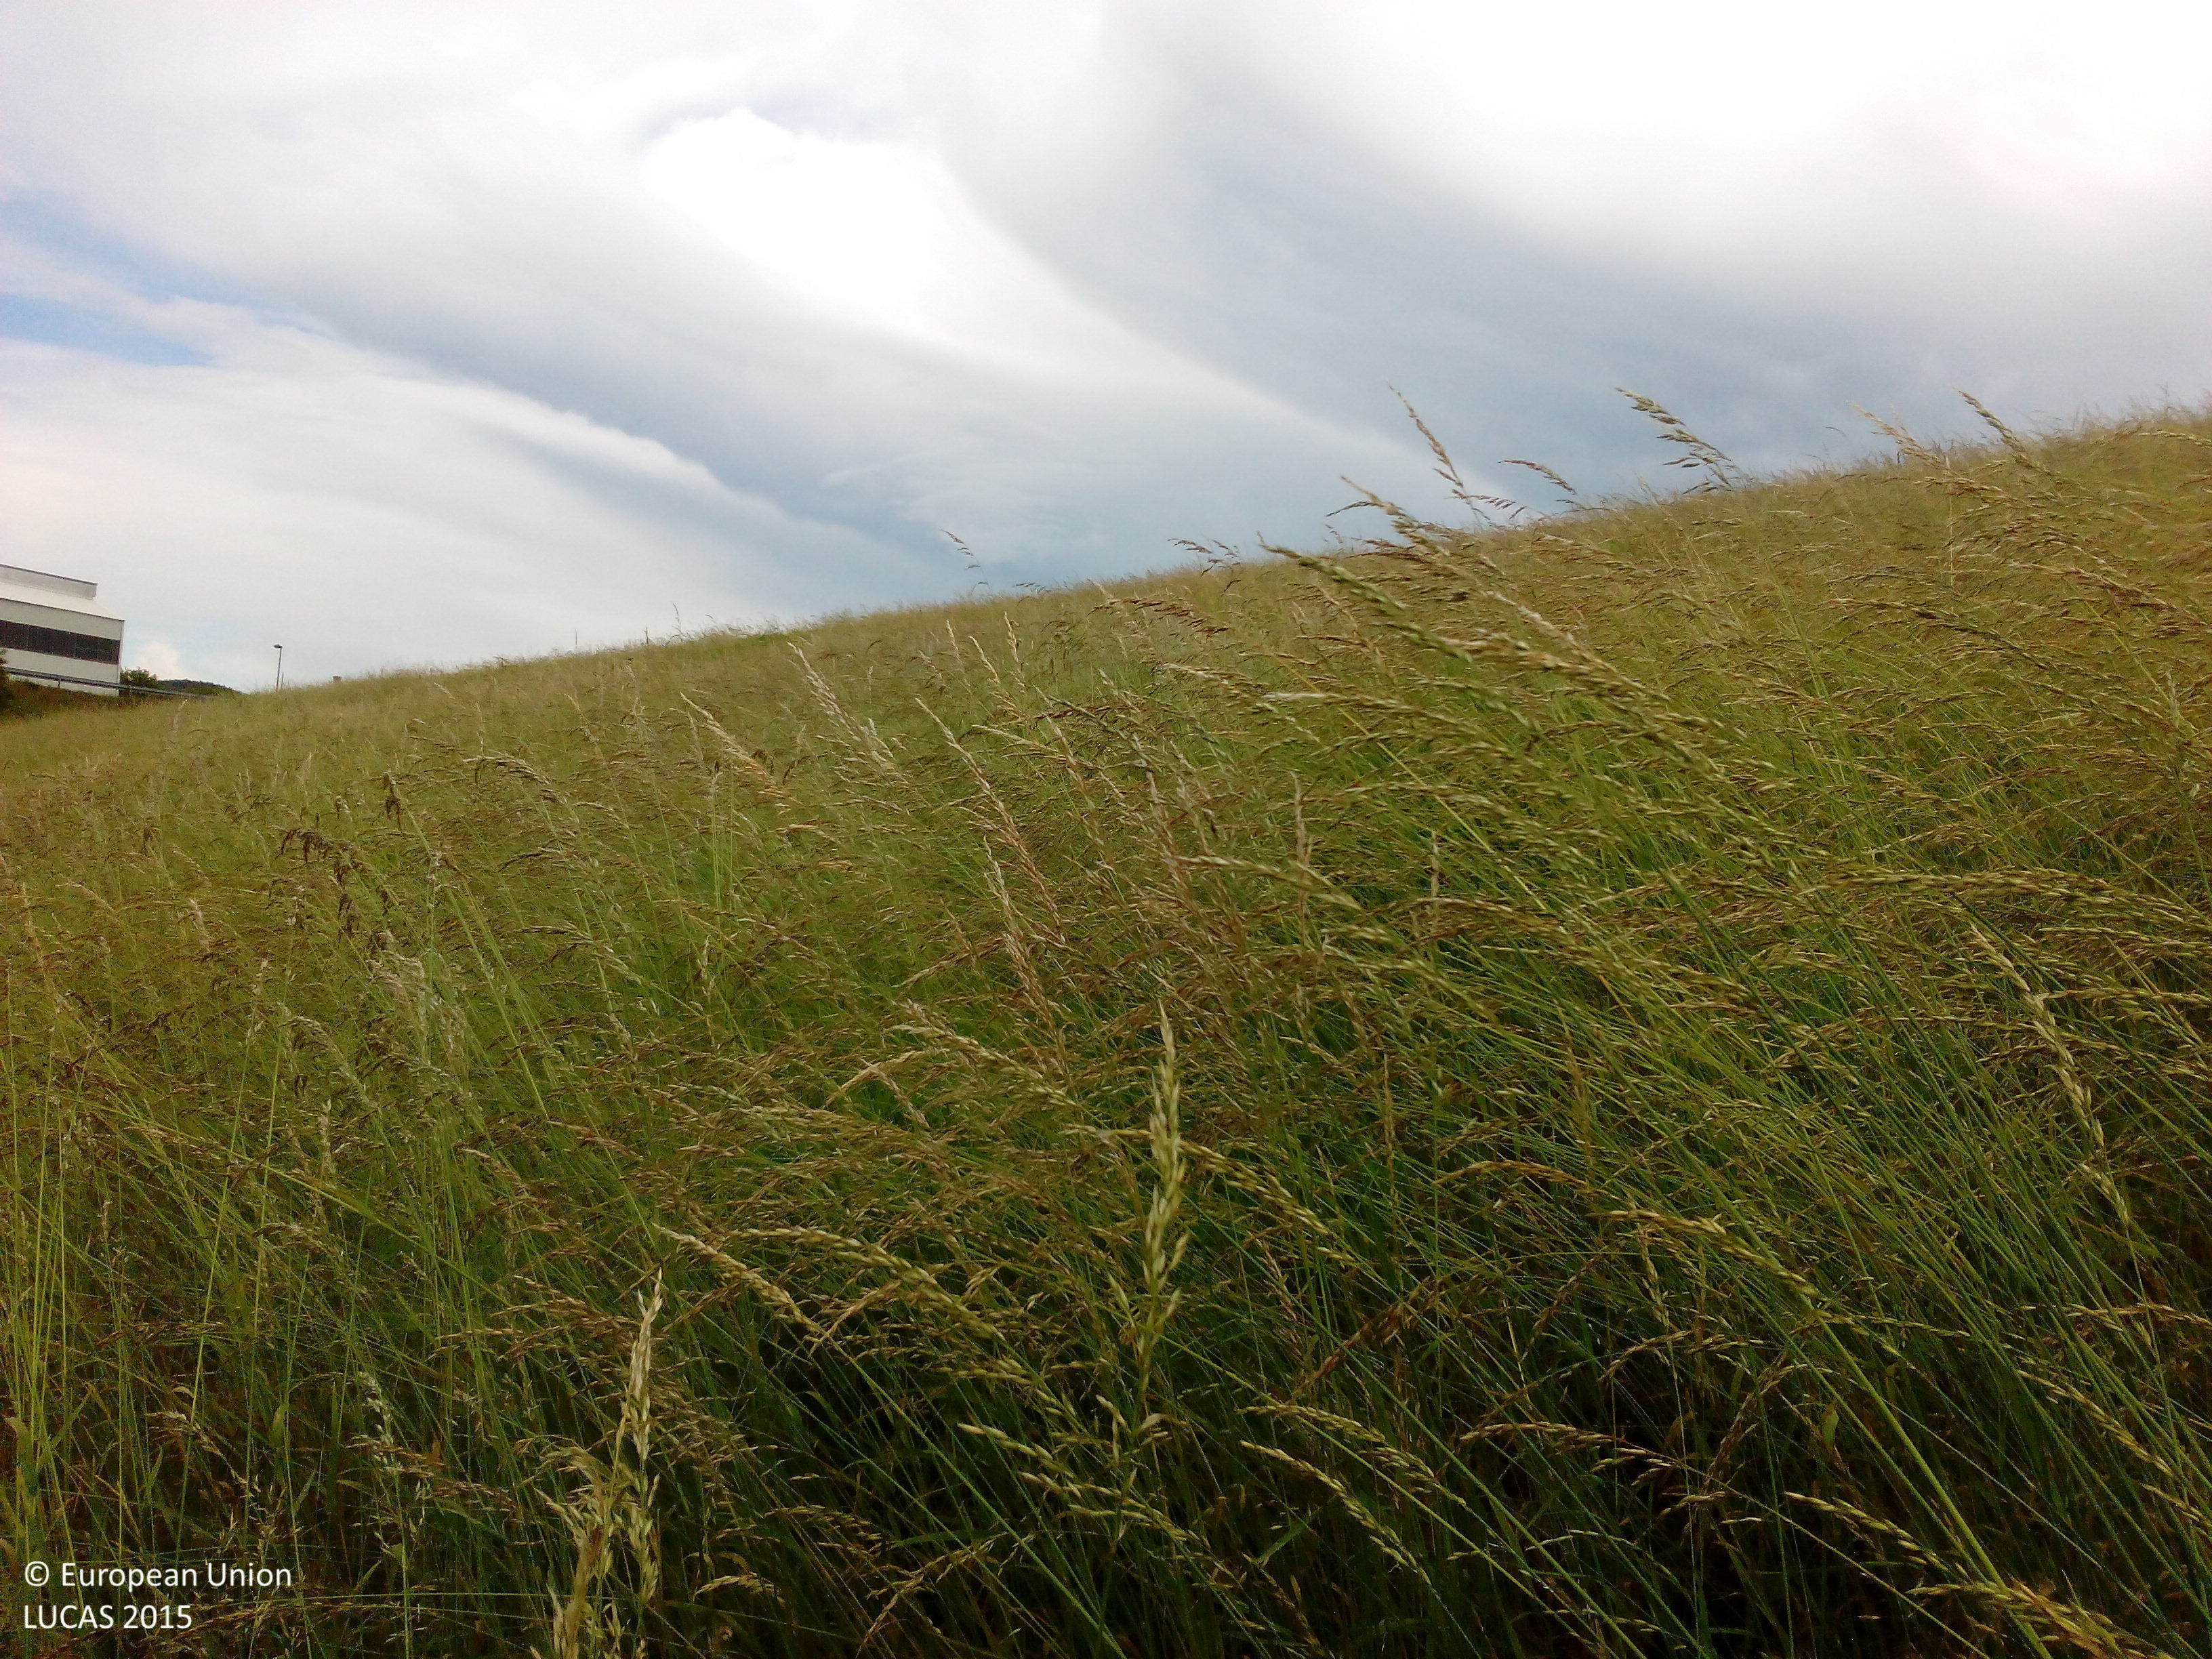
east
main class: Grassland
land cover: Grassland without tree/shrub cover
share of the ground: > 75 %
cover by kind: herbaceous plants 100 %
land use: Waste treatment
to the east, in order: Grassland without tree/shrub cover; Shrubland without tree cover; Grassland without tree/shrub cover; Paved roads, cycling and walking lanes; Shrubland without tree cover; Paved roads, cycling and walking lanes; Shrubland without tree cover; Paved roads, cycling and walking lanes; Shrubland without tree cover; Paved roads, cycling and walking lanes; Shrubland without tree cover; Fences; Broadleaved woodland; Grass margins; Tracks; Grass margins; Barley
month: June
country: DE
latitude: 50.7125
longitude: 11.6000
